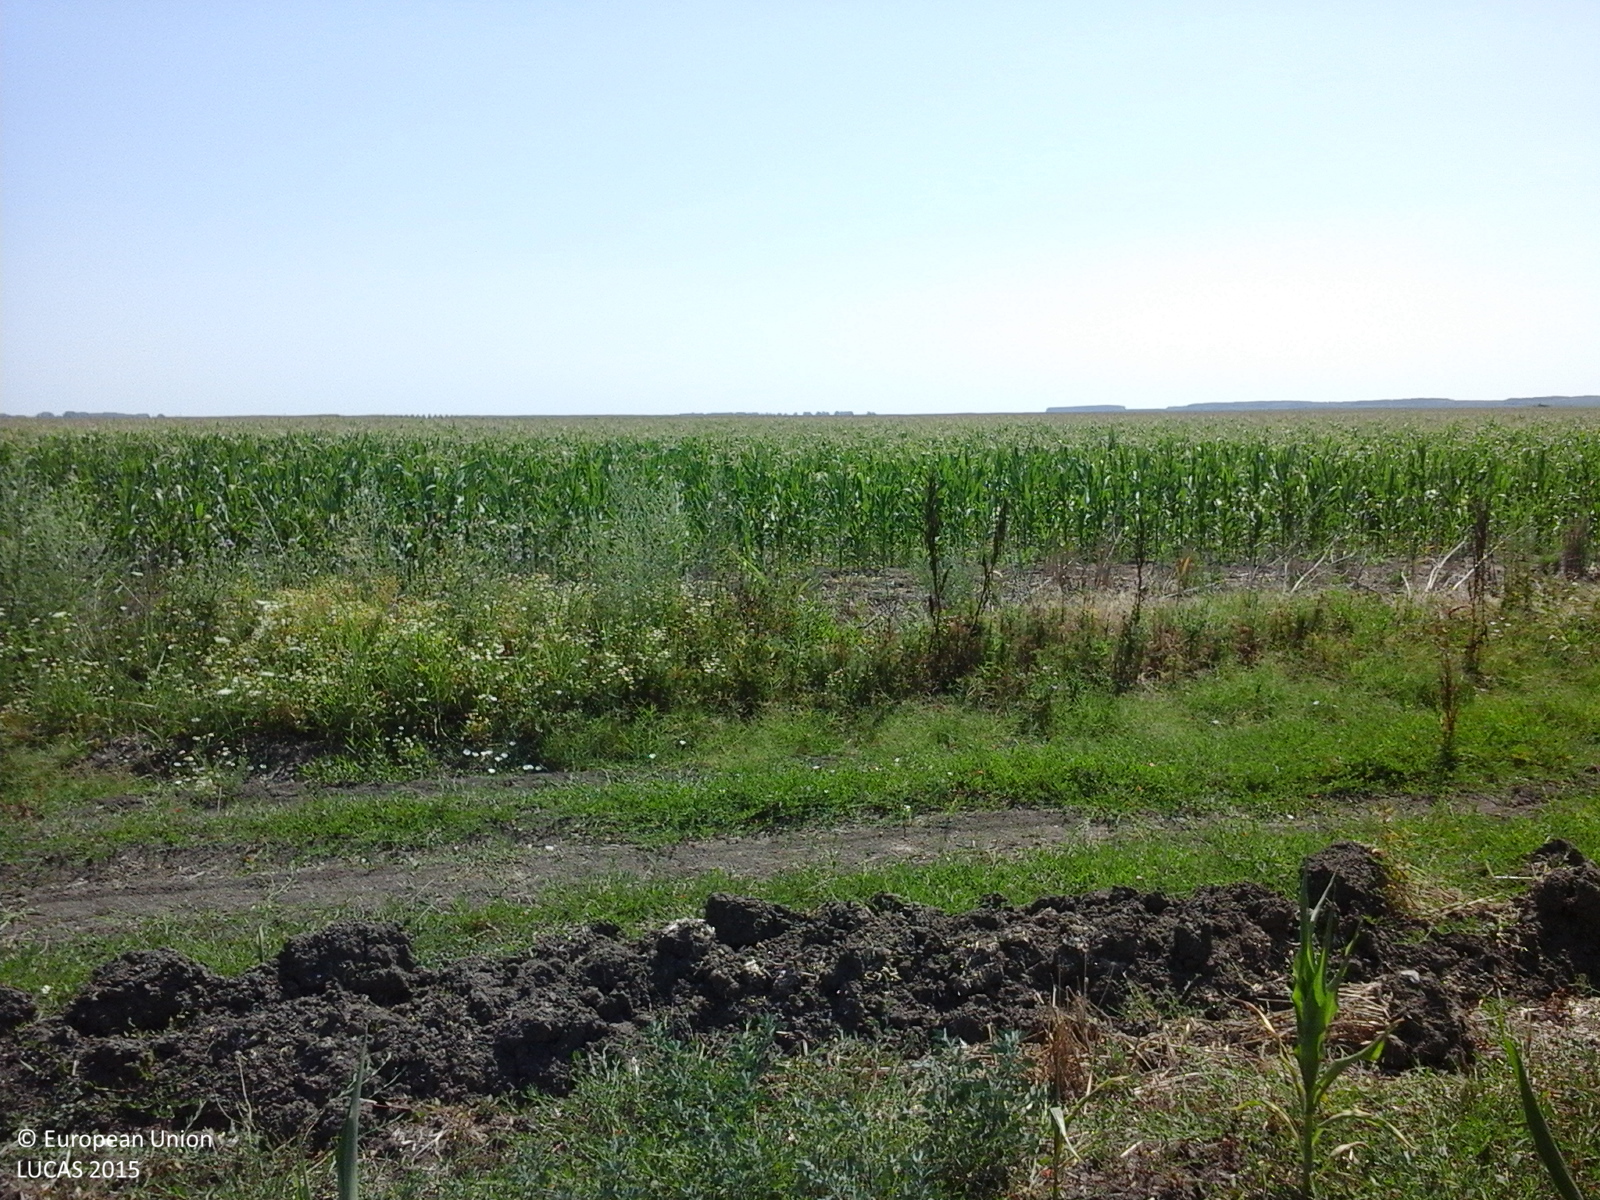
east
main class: Cropland
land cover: Maize
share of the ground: > 75 %
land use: Agriculture (excluding fallow land and kitchen gardens)
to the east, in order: Maize; Electric lines; Maize; Grass margins; Tracks; Grassland without tree/shrub cover; Ditches and canals; Grass margins; Maize
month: July
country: RO
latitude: 44.1687
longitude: 26.9962
